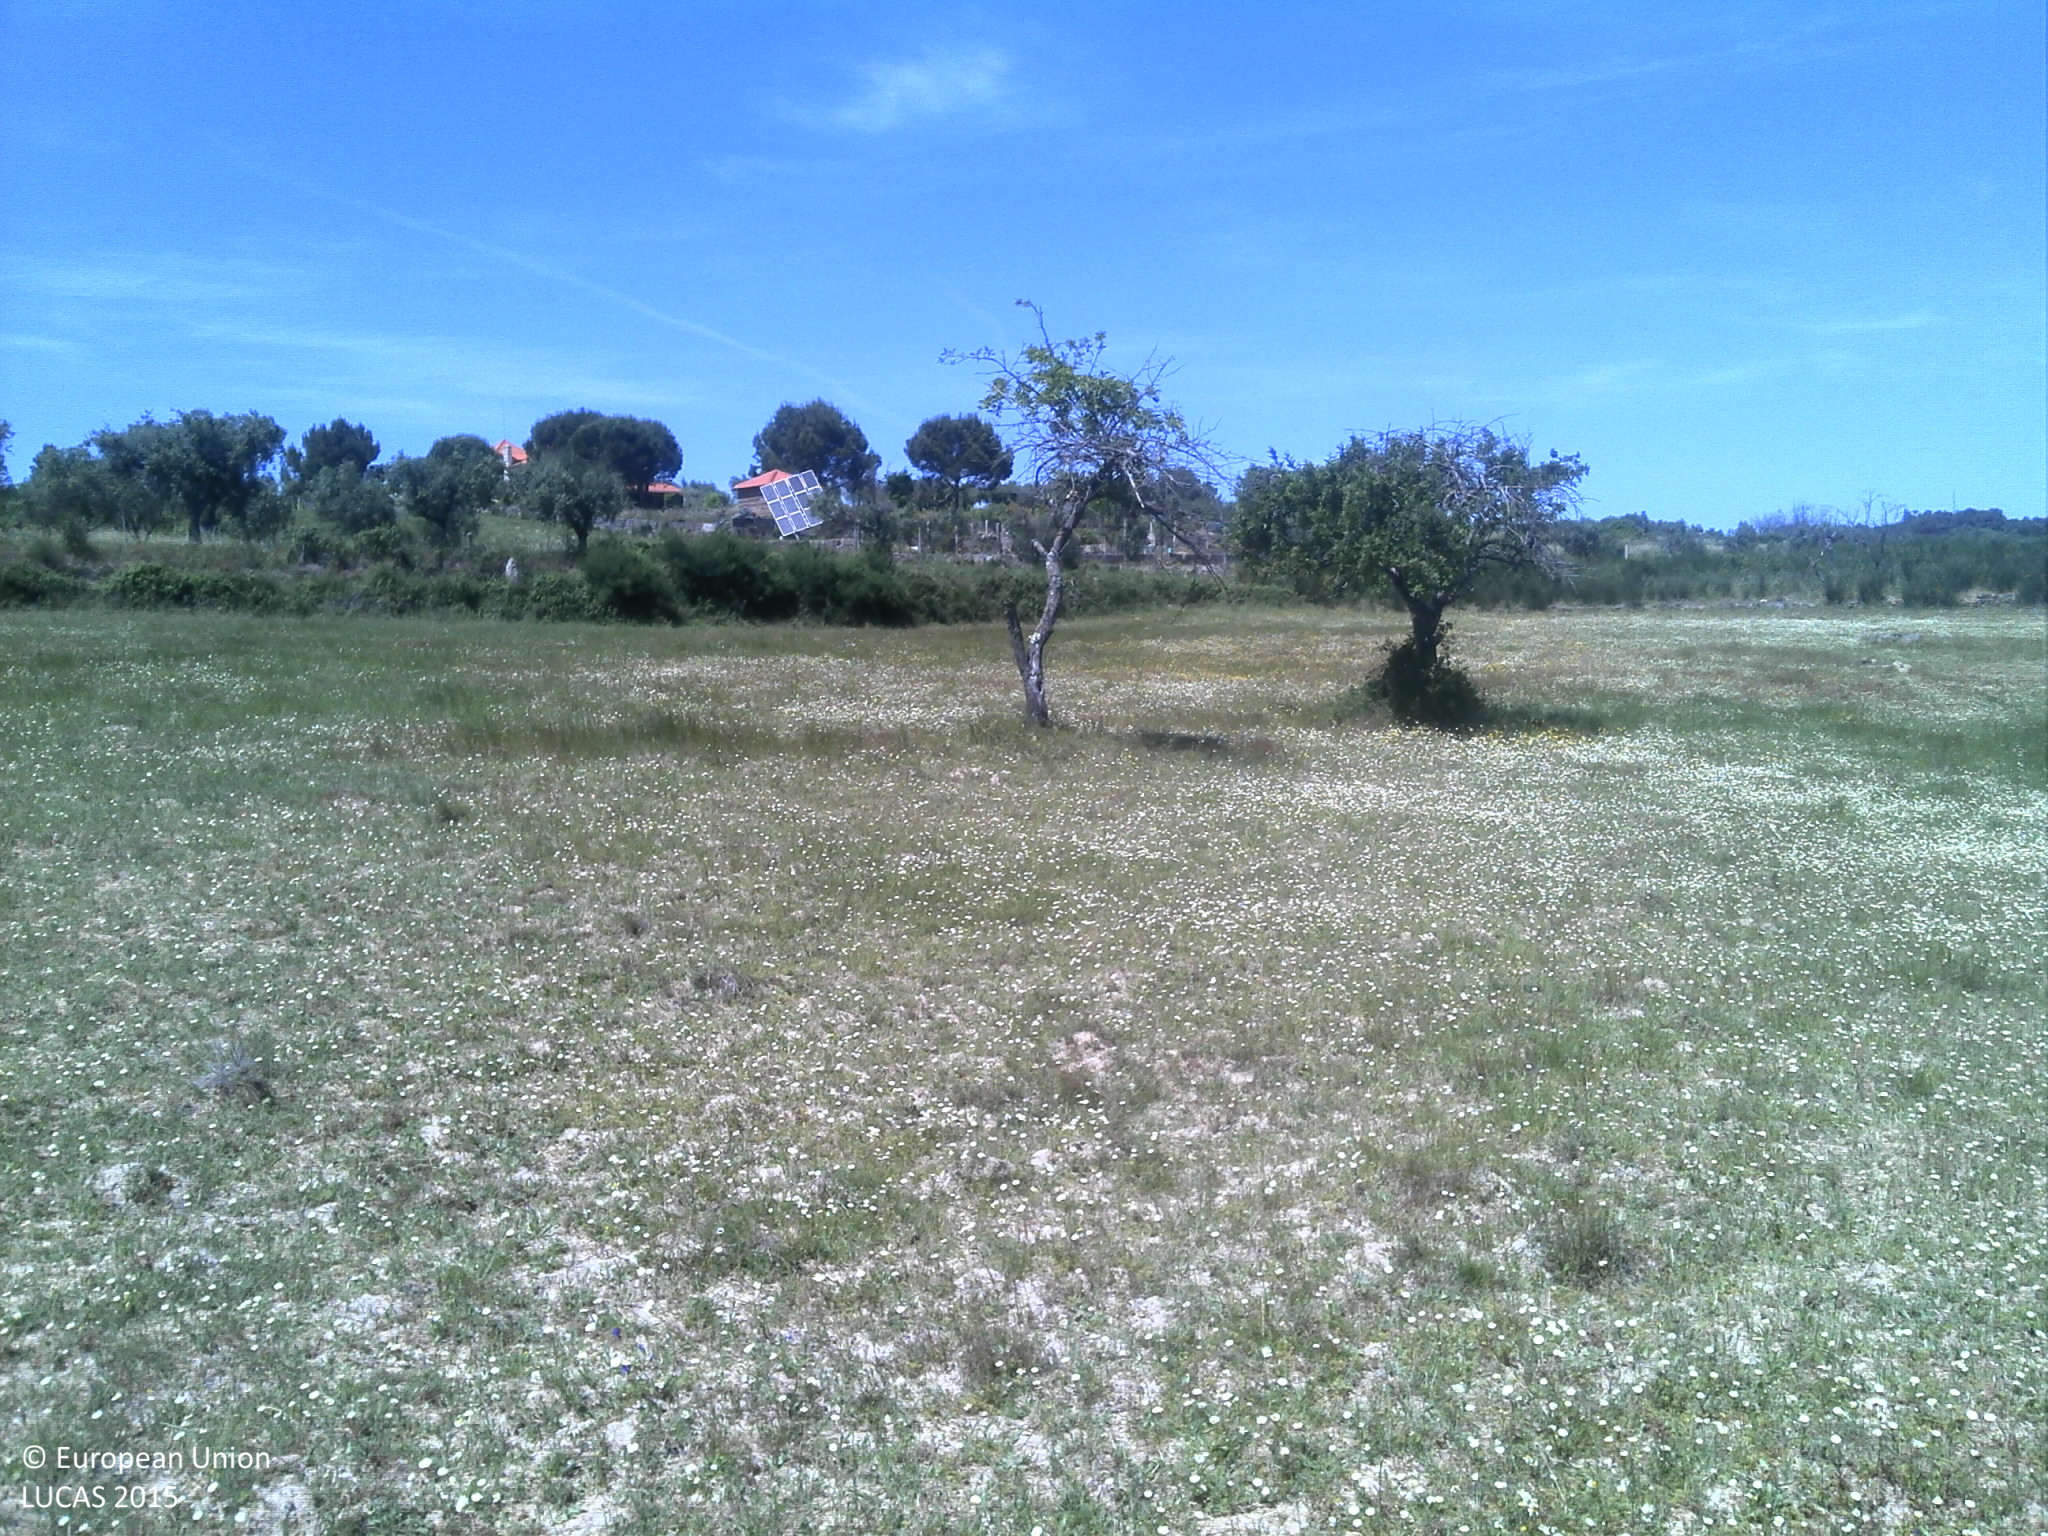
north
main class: Grassland
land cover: Grassland without tree/shrub cover
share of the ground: 25 - 50 %
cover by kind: herbaceous plants 50 %, unconsolidated bare surface 50 %
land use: Agriculture (excluding fallow land and kitchen gardens)
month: May
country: PT
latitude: 40.4845
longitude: -7.7296
